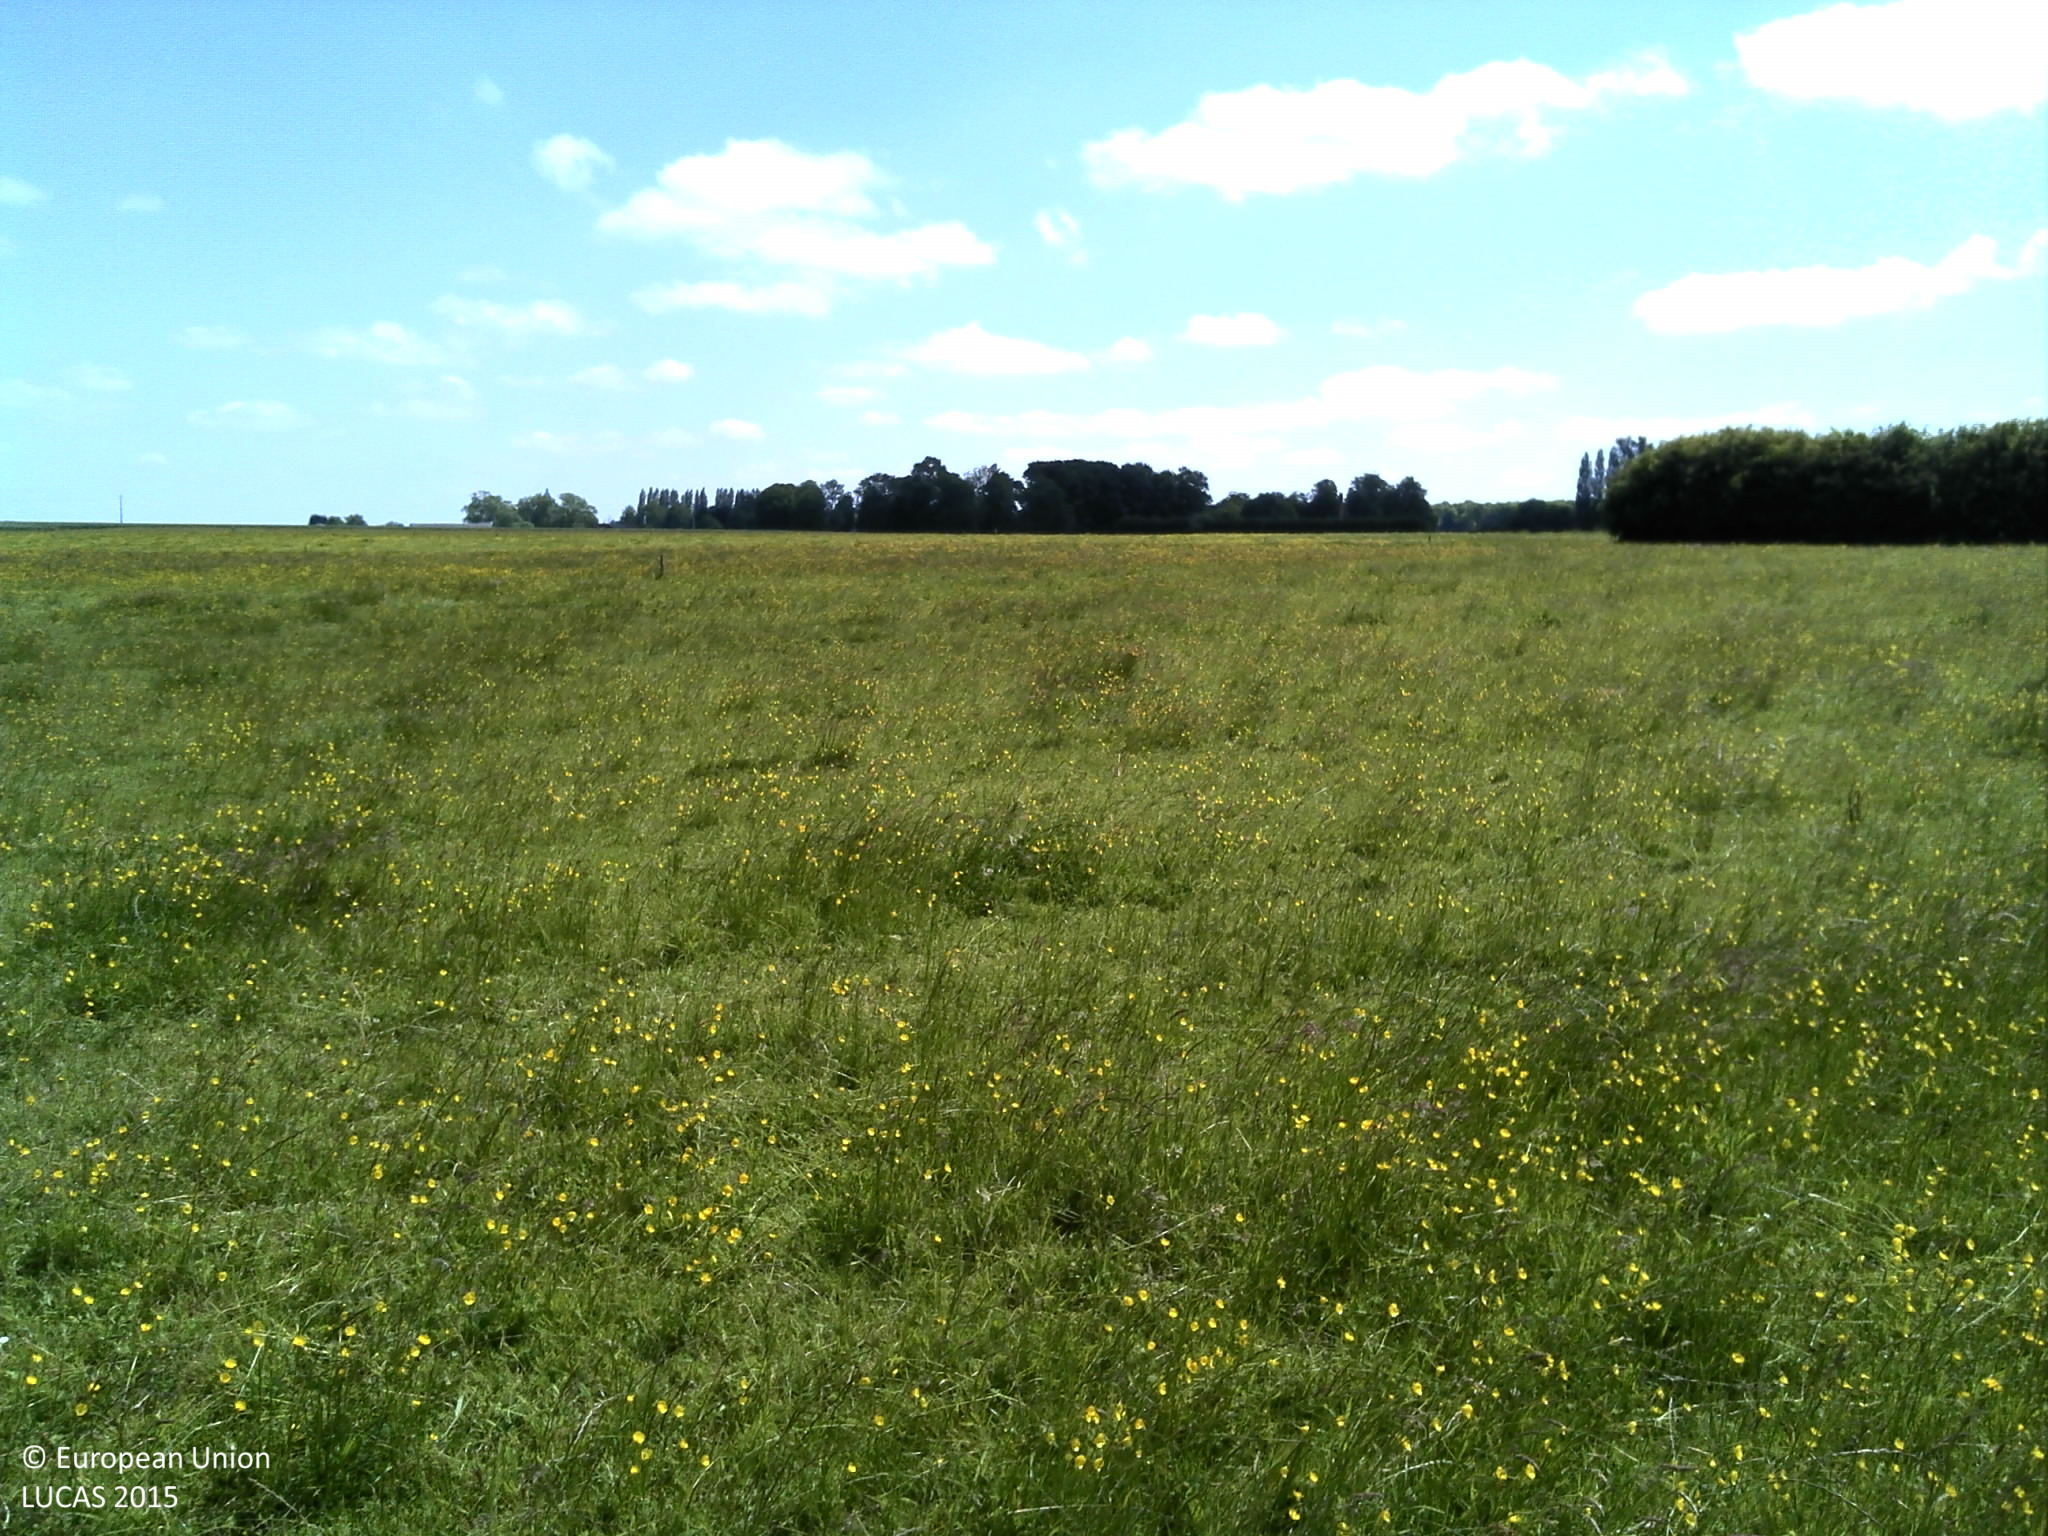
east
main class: Grassland
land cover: Grassland without tree/shrub cover
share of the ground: > 75 %
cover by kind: herbaceous plants 100 %
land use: Agriculture (excluding fallow land and kitchen gardens)
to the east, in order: Grassland without tree/shrub cover; Fences; Grassland without tree/shrub cover; Fences; Grassland without tree/shrub cover; Fences; Grassland without tree/shrub cover
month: June
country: FR
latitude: 49.5298
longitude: 1.1223
